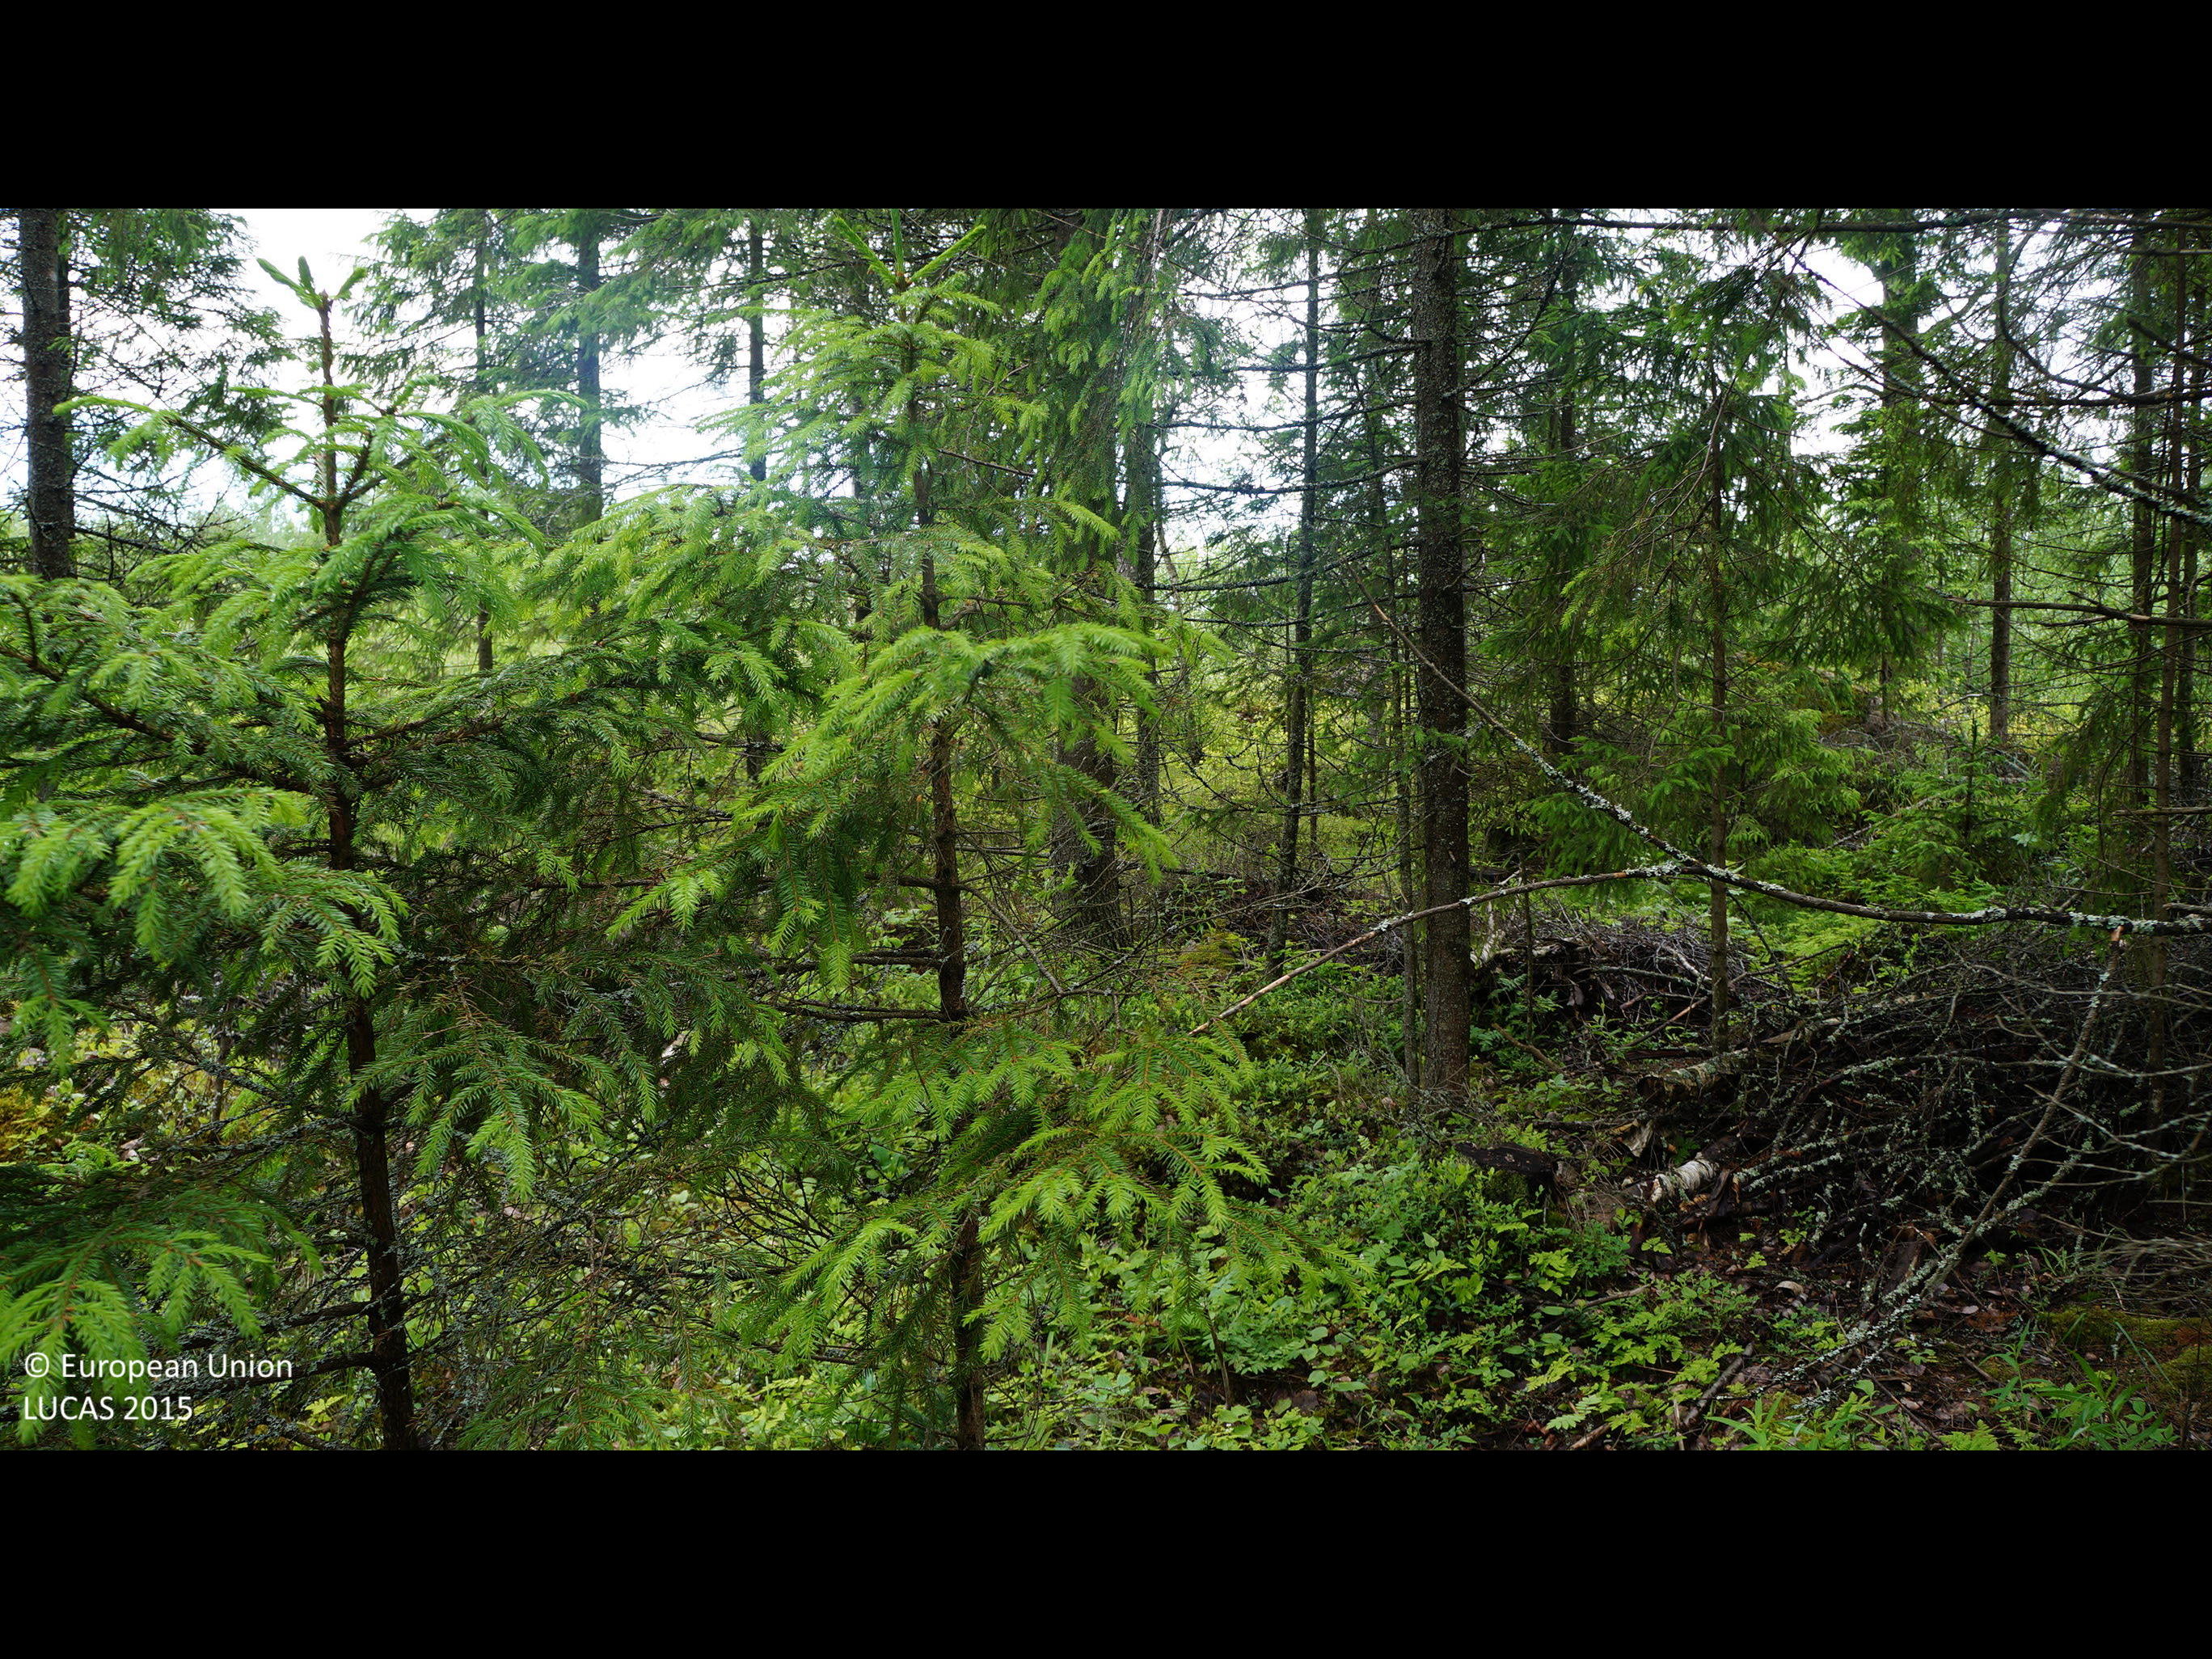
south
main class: Woodland
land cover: Spruce dominated coniferous woodland
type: boreal forest
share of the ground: 50 - 75 %
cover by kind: coniferous forest trees 45 %, shrubs 25 %, herbaceous plants 20 %, broadleaved forest trees 5 %, lichens and mosses 5 %
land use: Forestry
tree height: > 5 m
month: June
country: FI
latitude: 63.9001
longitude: 23.4009
